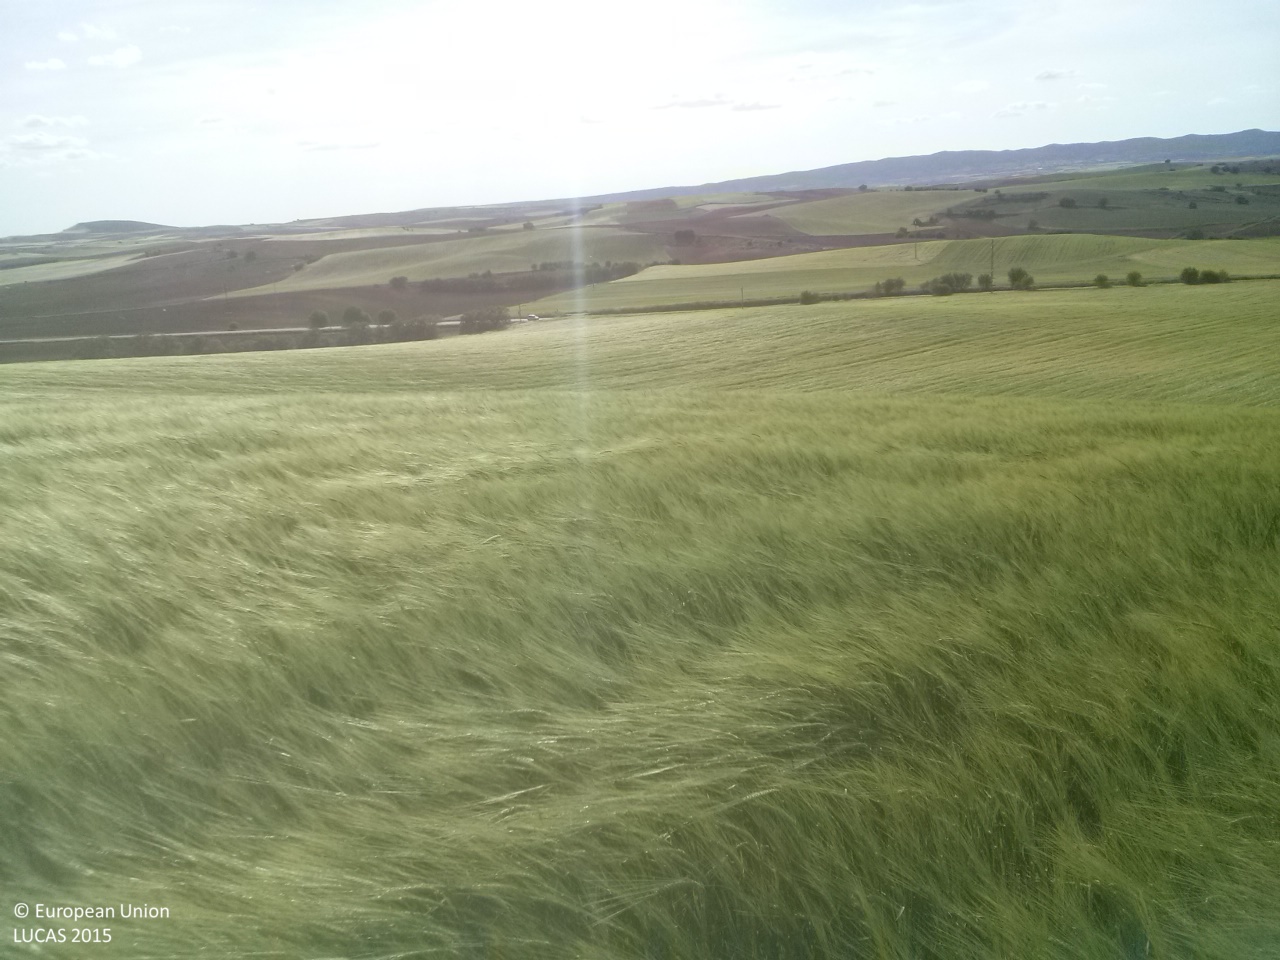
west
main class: Cropland
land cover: Barley
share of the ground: > 75 %
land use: Agriculture (excluding fallow land and kitchen gardens)
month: May
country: ES
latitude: 40.0966
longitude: -2.7015
